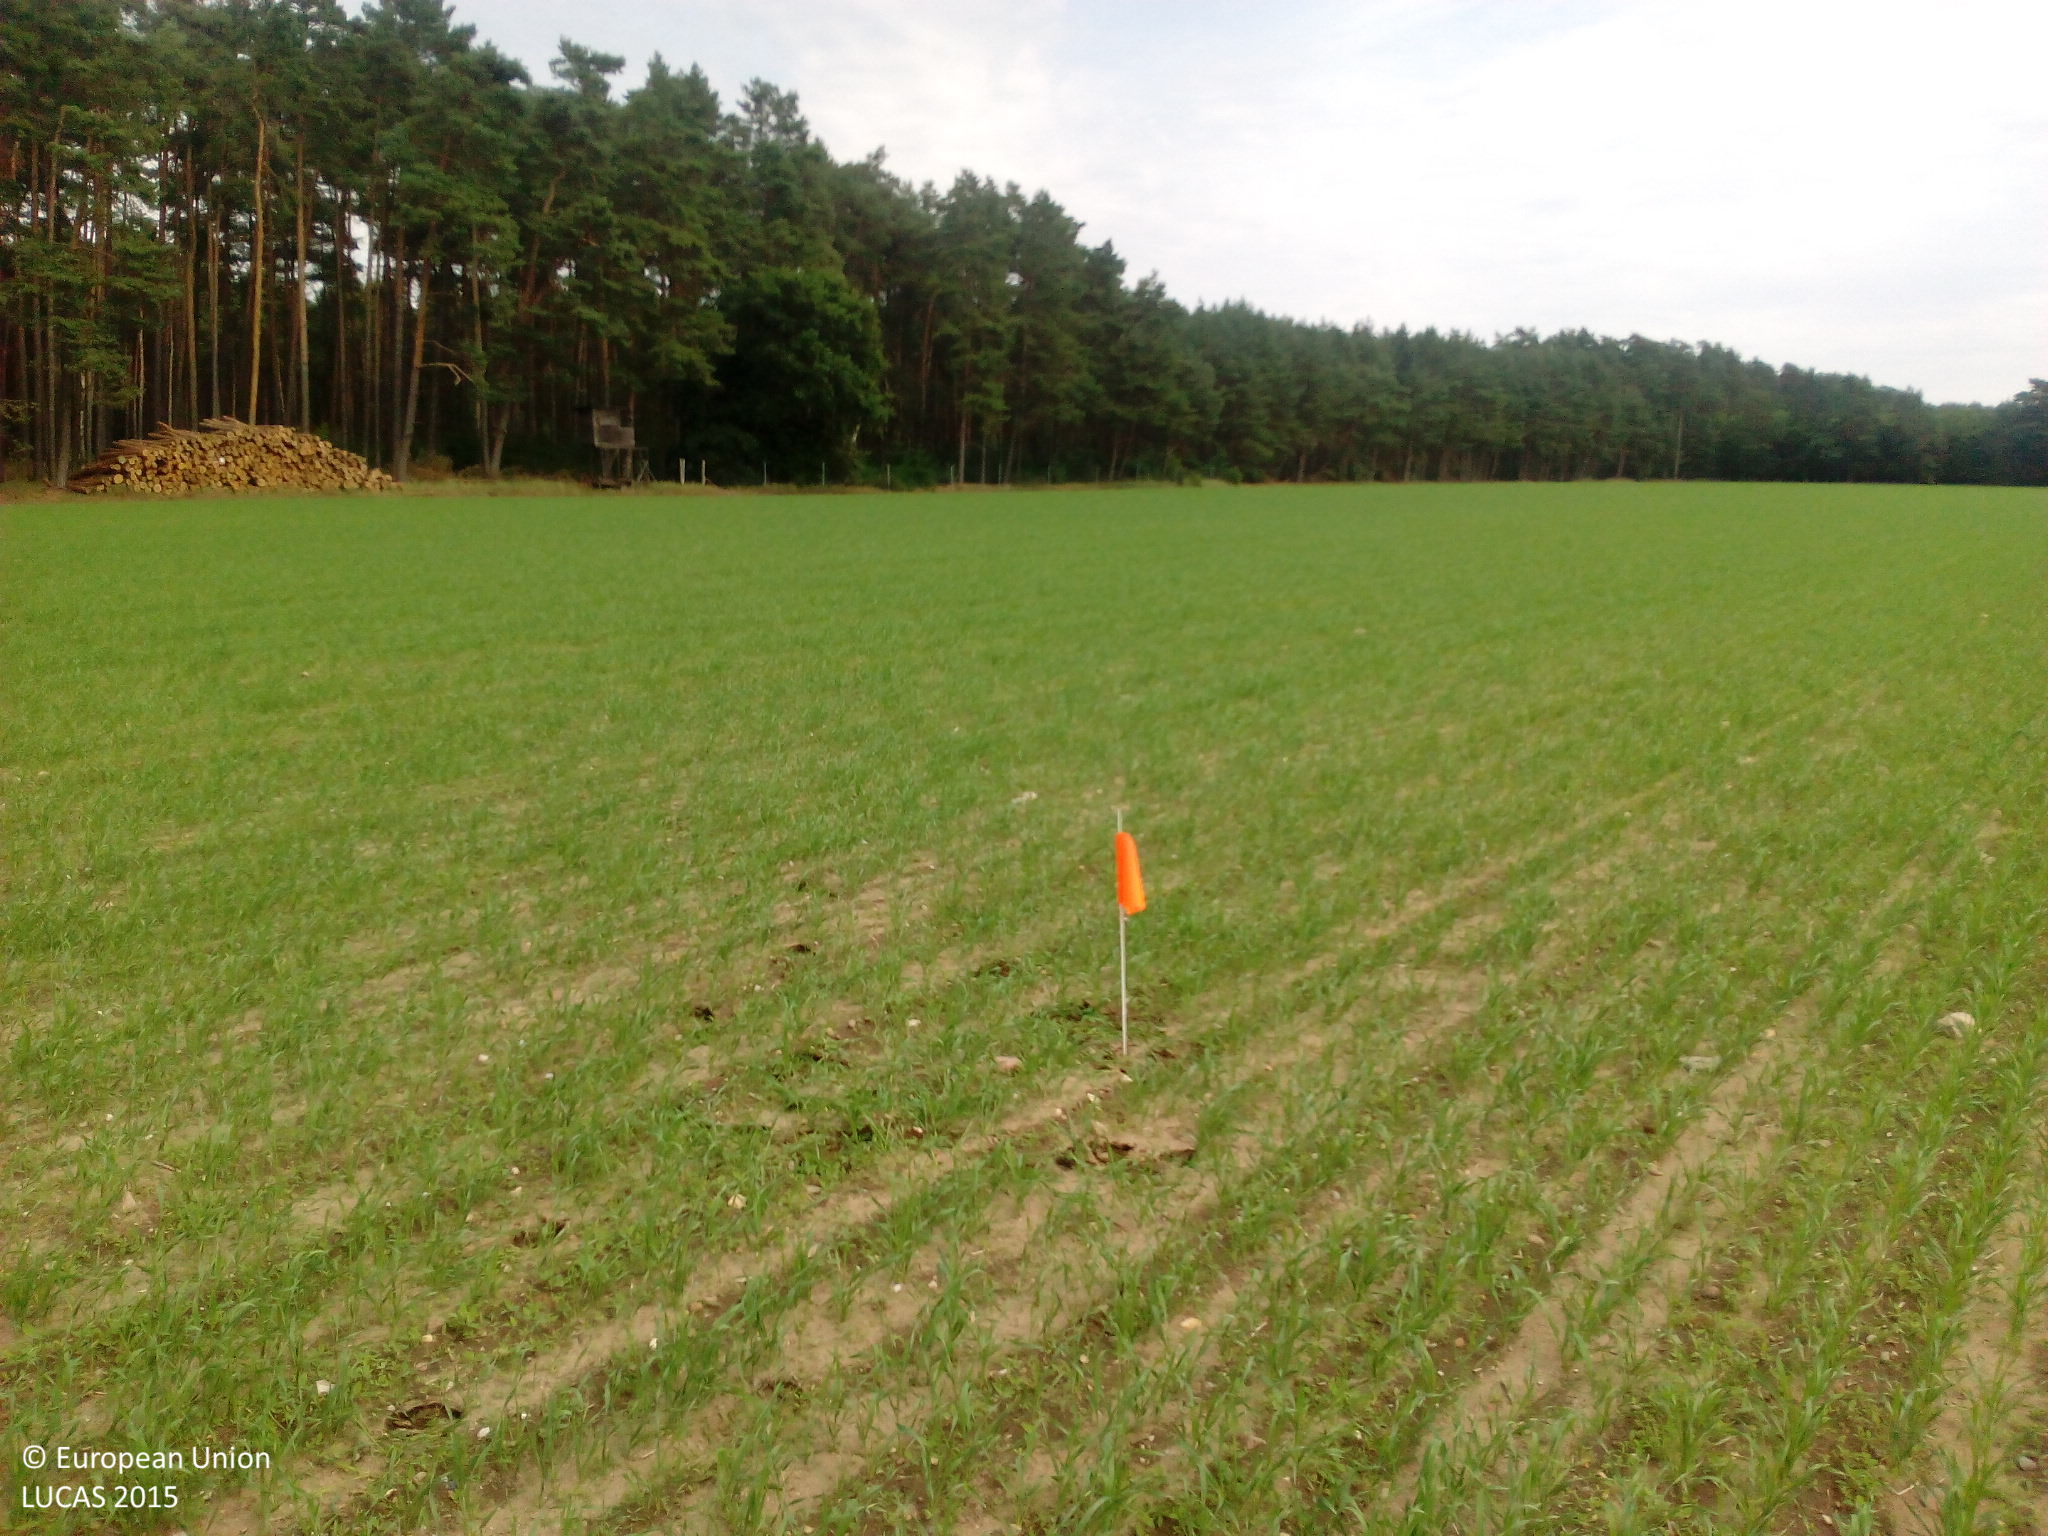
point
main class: Cropland
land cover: Common wheat
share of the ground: 25 - 50 %
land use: Agriculture (excluding fallow land and kitchen gardens)
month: July
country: DE
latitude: 52.0115
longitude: 12.4036
